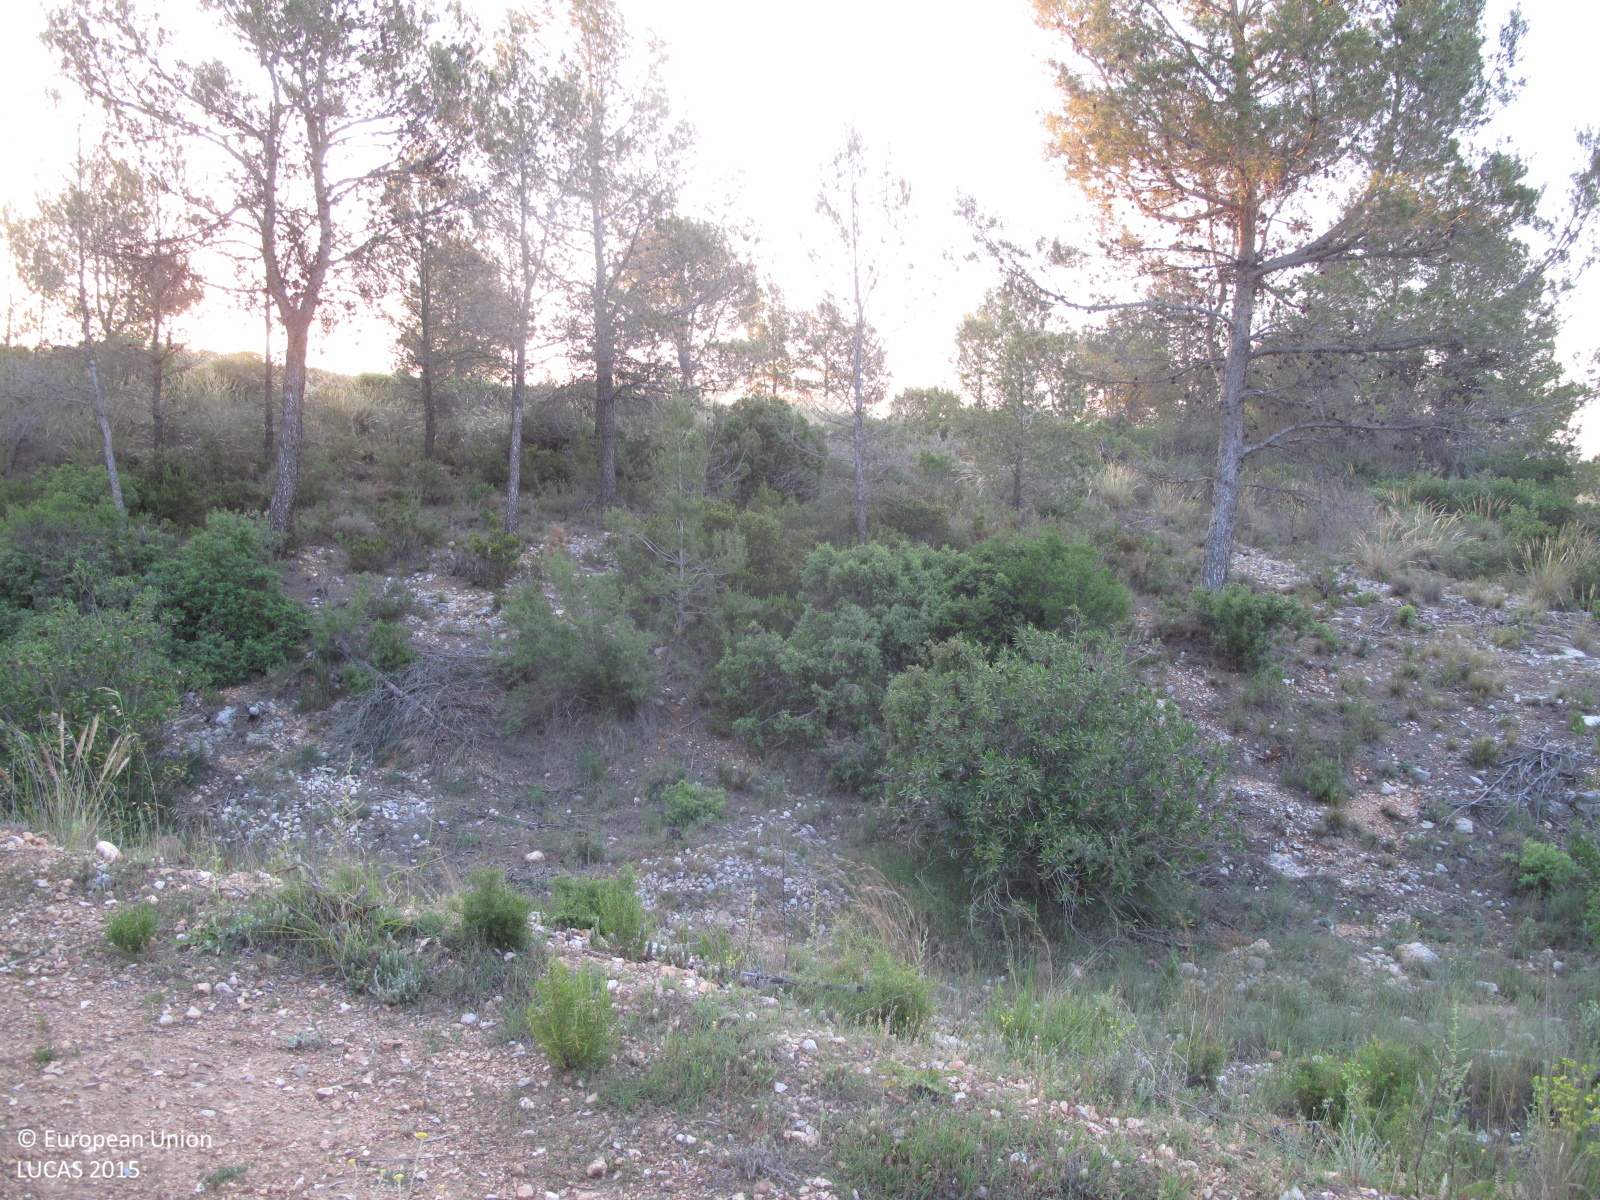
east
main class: Cropland
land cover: Olive groves
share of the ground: 25 - 50 %
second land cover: Spontaneously vegetated surfaces
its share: 25 - 50 %
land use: Agriculture (excluding fallow land and kitchen gardens)
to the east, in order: Olive groves; Spontaneously vegetated surfaces; Electric lines; Olive groves; Grassland with sparse tree/shrub cover; Pine dominated coniferous woodland; Shrubland with sparse tree cover; Oats
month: May
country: ES
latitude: 38.8878
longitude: -0.7719
